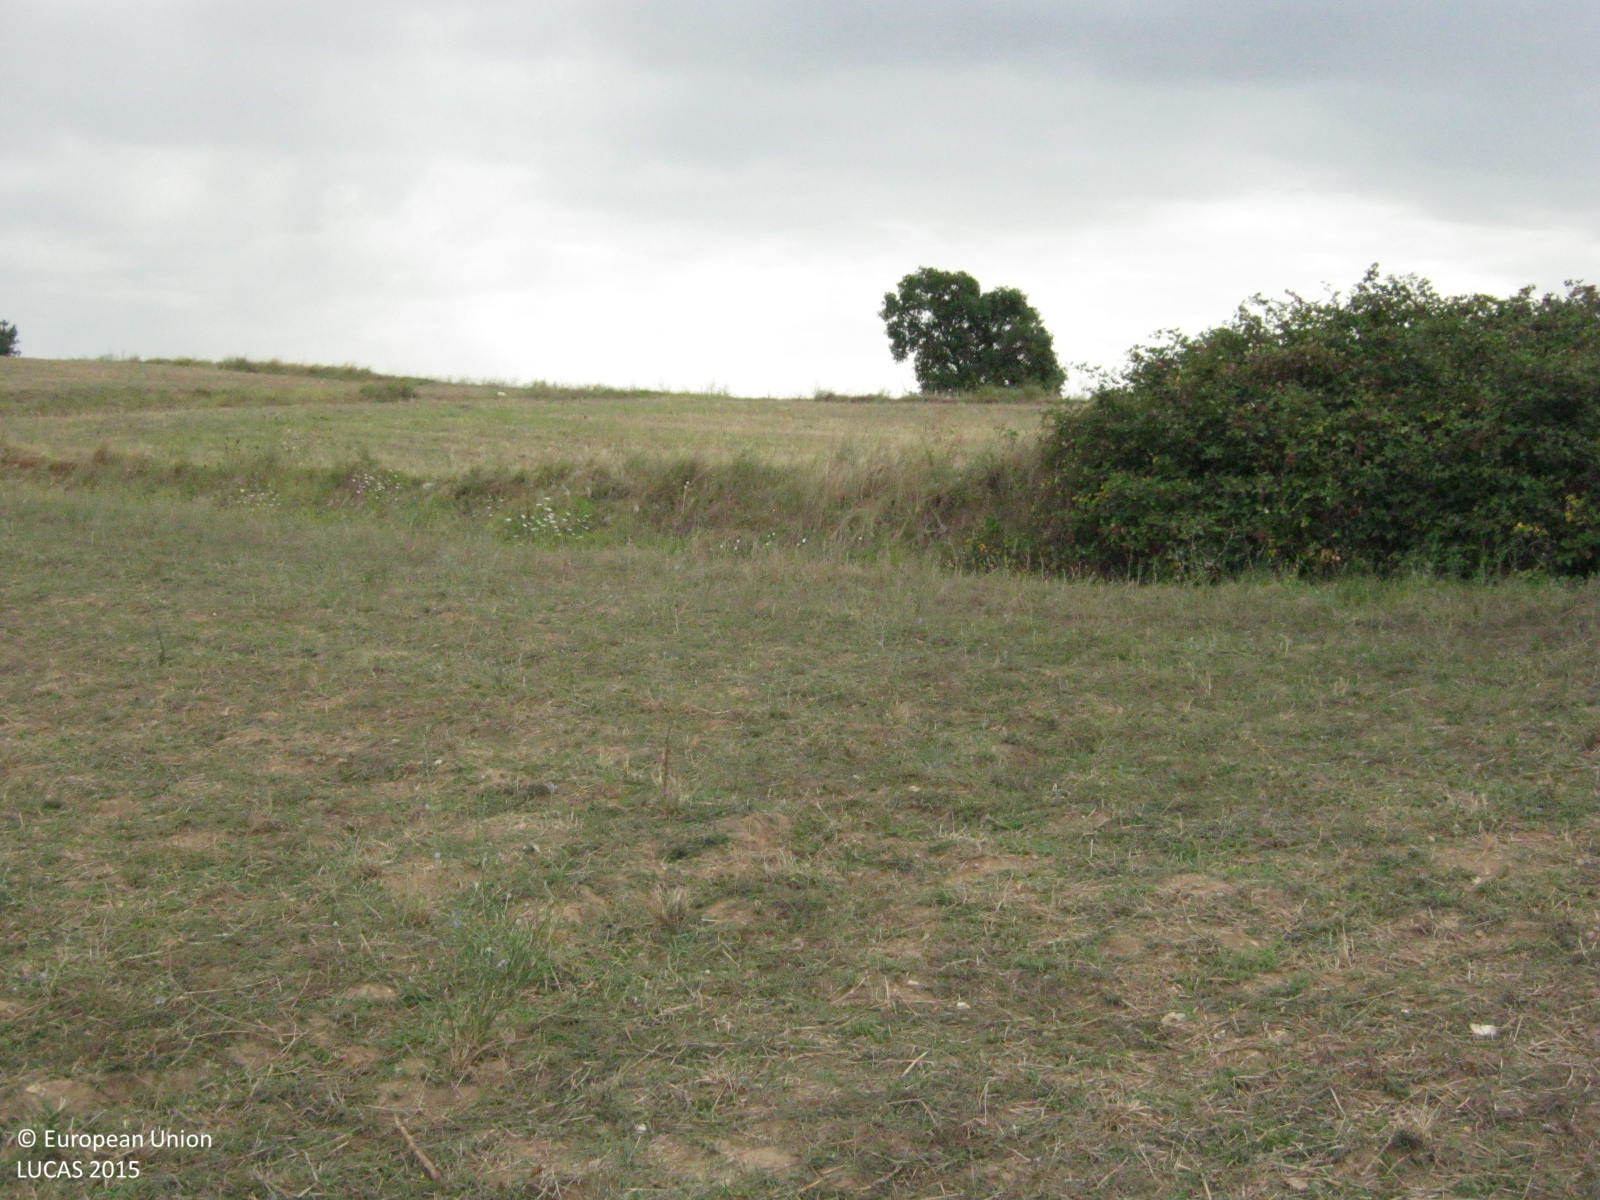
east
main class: Grassland
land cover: Spontaneously vegetated surfaces
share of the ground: > 75 %
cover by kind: herbaceous plants 90 %, consolidated bare surface 10 %
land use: Agriculture (excluding fallow land and kitchen gardens)
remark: Harvested field
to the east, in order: Spontaneously vegetated surfaces; Shruby margins; Spontaneously vegetated surfaces; Grass margins; Paved roads, cycling and walking lanes; Shrubland without tree cover; Common wheat; Shruby margins; Common wheat; Electric lines; Common wheat; Broadleaved woodland; Shrubland with sparse tree cover
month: August
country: GR
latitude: 40.9004
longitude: 22.9853
